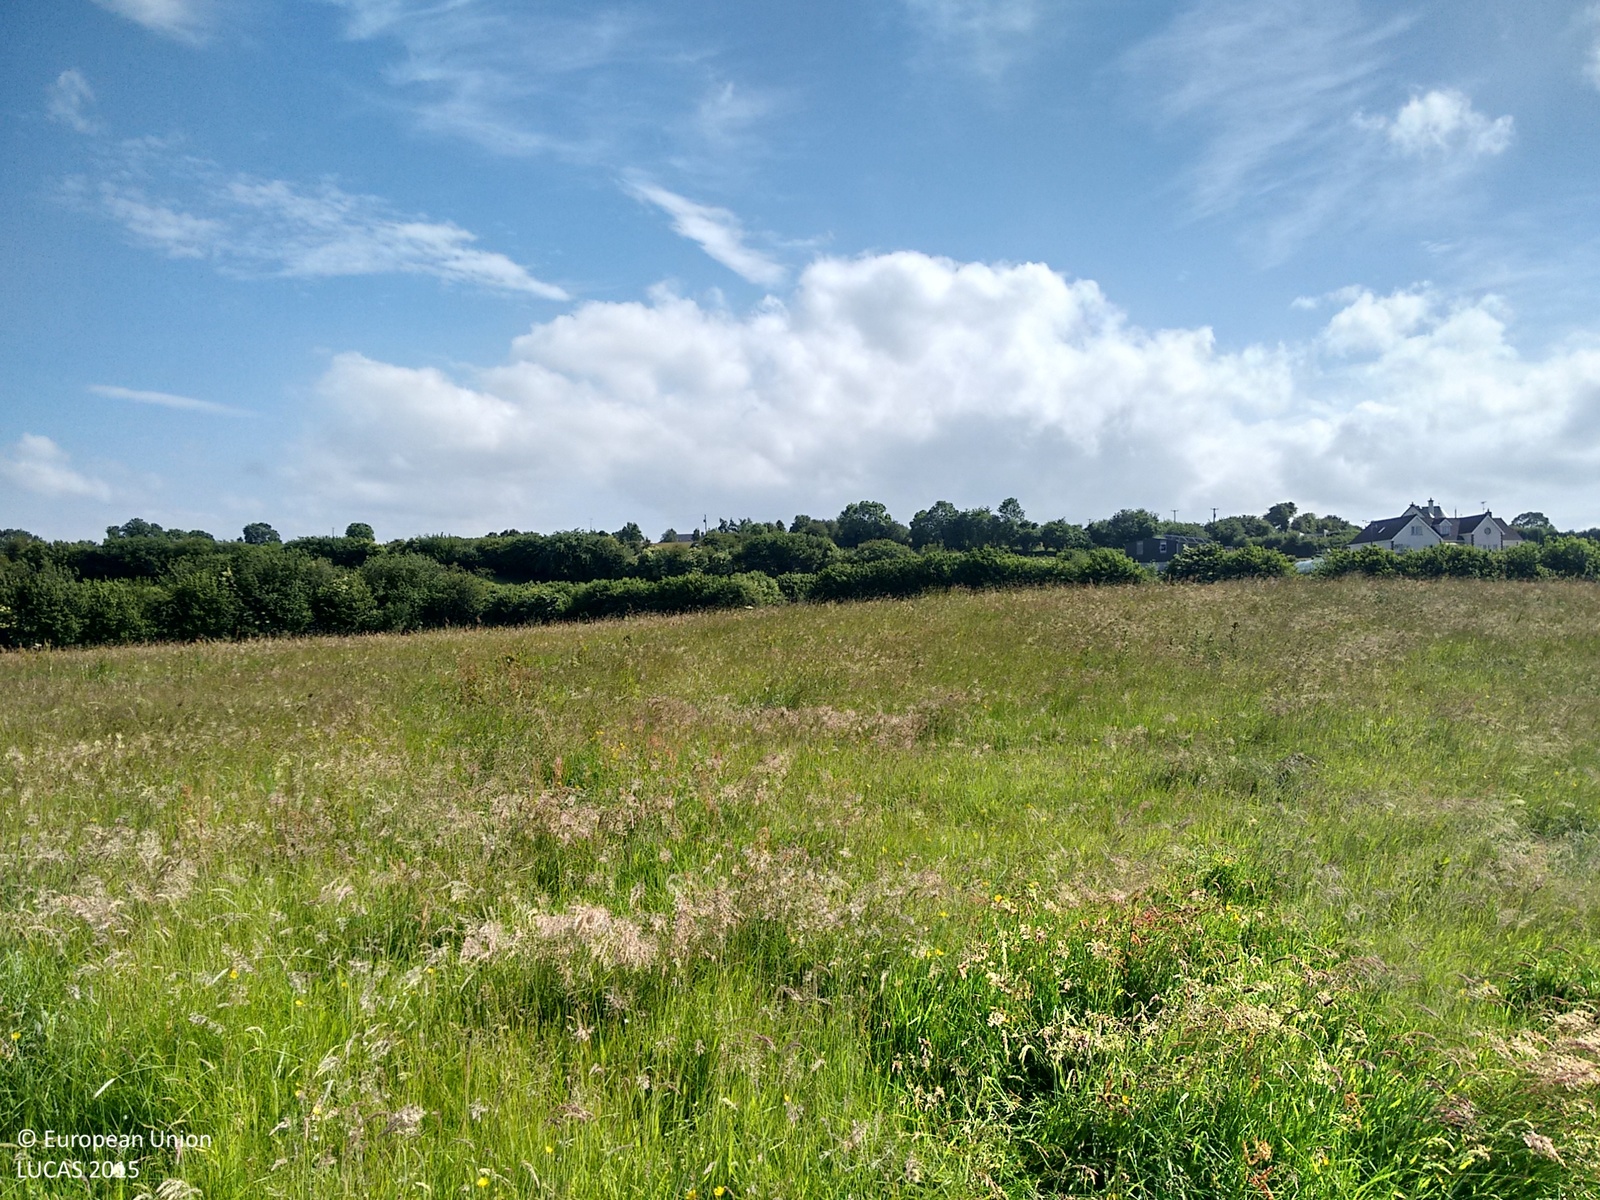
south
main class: Grassland
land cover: Grassland without tree/shrub cover
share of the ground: > 75 %
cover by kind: herbaceous plants 100 %
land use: Agriculture (excluding fallow land and kitchen gardens)
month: June
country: IE
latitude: 53.4374
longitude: -7.7643
